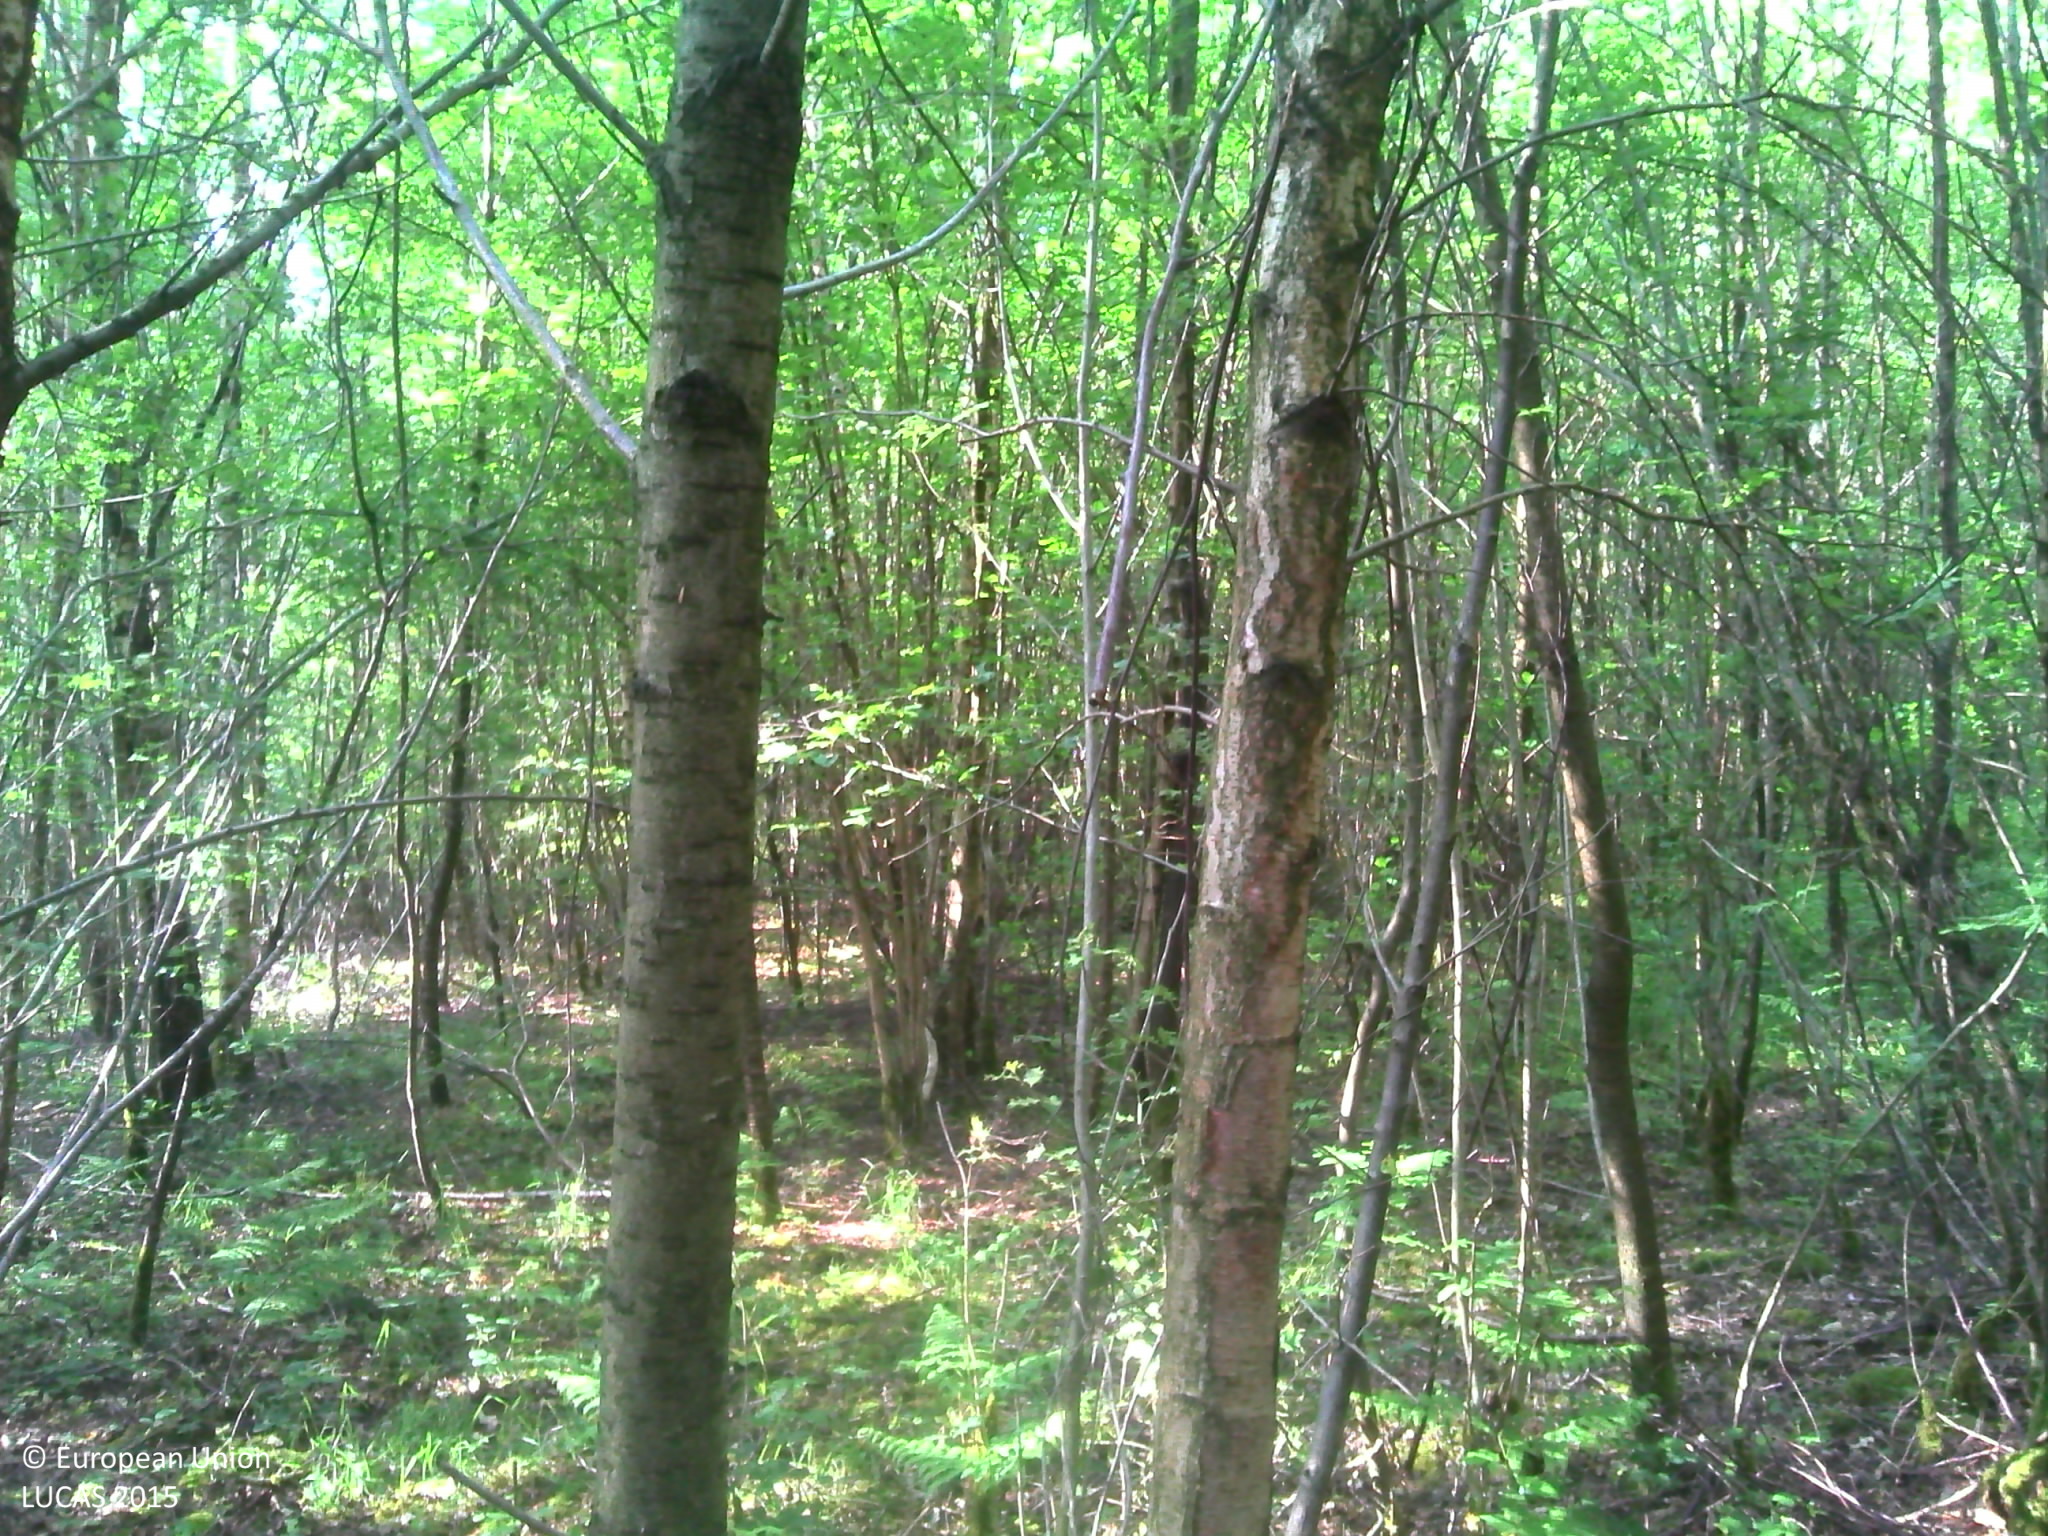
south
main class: Woodland
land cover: Broadleaved woodland
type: acidophilous oak and oak-birch forest
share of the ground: > 75 %
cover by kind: broadleaved forest trees 100 %
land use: Forestry
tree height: > 5 m
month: June
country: BE
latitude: 50.0366
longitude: 4.5650
